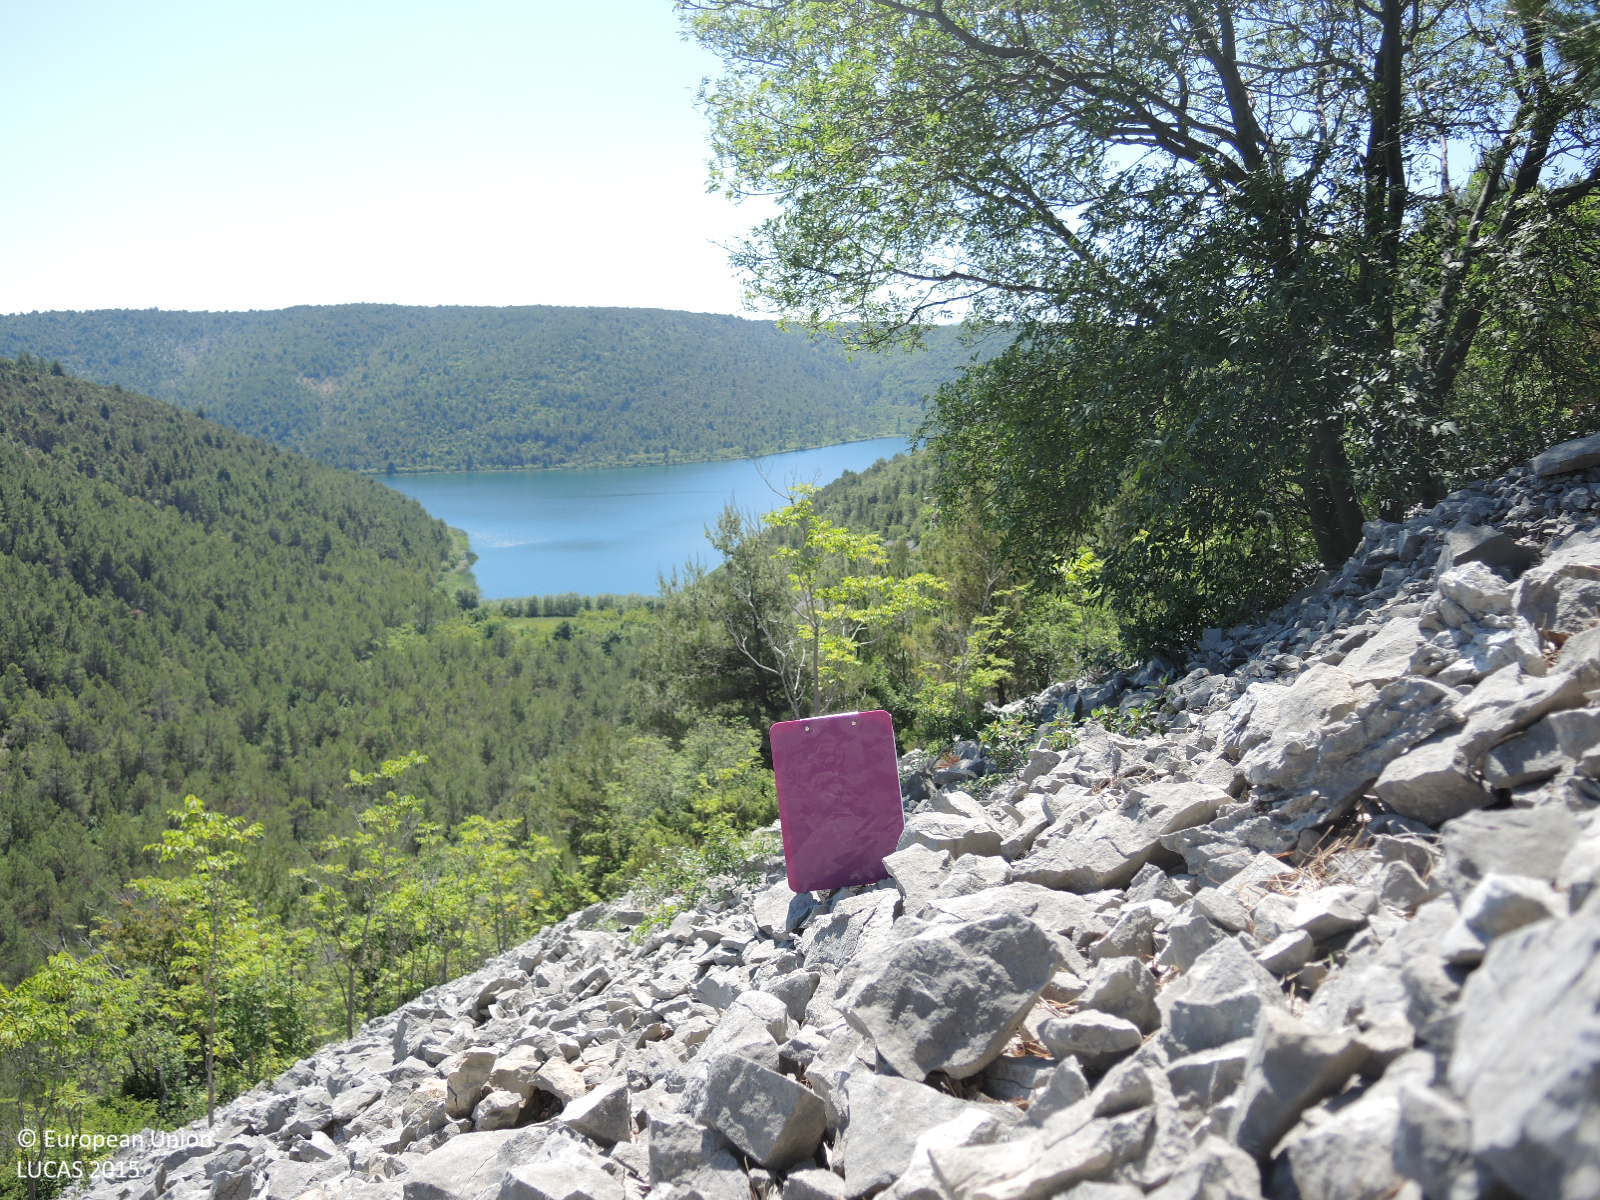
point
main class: Woodland
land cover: Pine dominated coniferous woodland
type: coniferous forest of the mediterranean region
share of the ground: 10 - 25 %
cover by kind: unconsolidated bare surface 65 %, coniferous forest trees 20 %, consolidated bare surface 10 %, shrubs 5 %
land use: Semi-natural and natural areas not in use
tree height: > 5 m
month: May
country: HR
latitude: 43.8349
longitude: 15.9734
